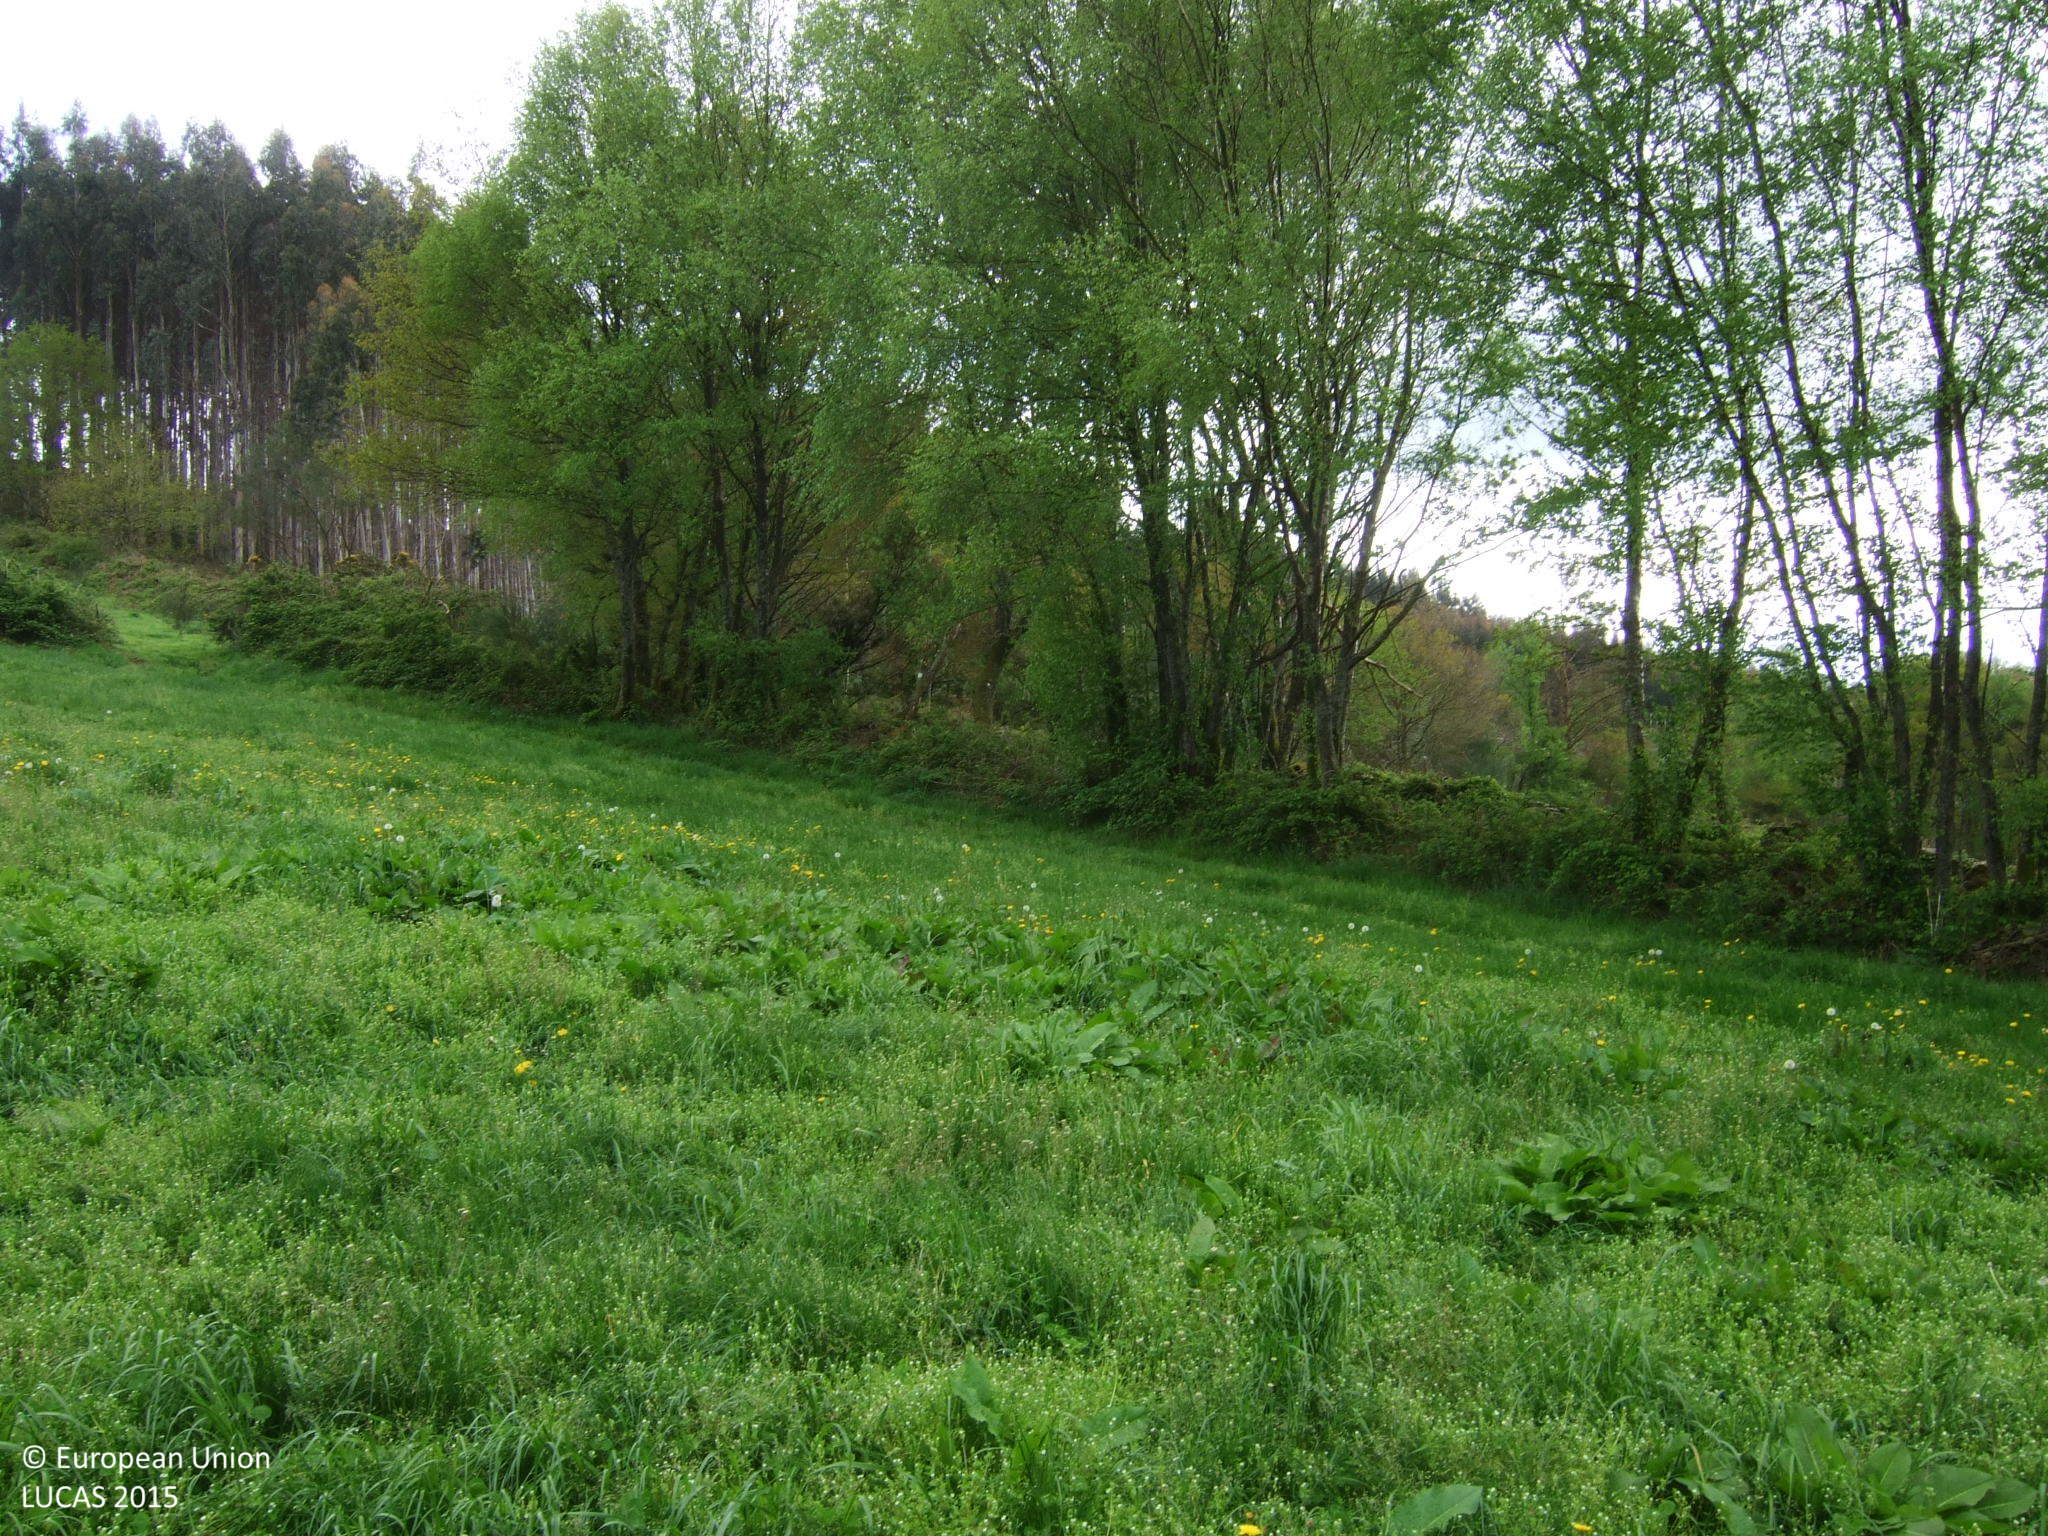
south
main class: Grassland
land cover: Grassland without tree/shrub cover
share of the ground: > 75 %
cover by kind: herbaceous plants 100 %
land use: Agriculture (excluding fallow land and kitchen gardens)
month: April
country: ES
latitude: 42.9890
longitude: -7.8568
